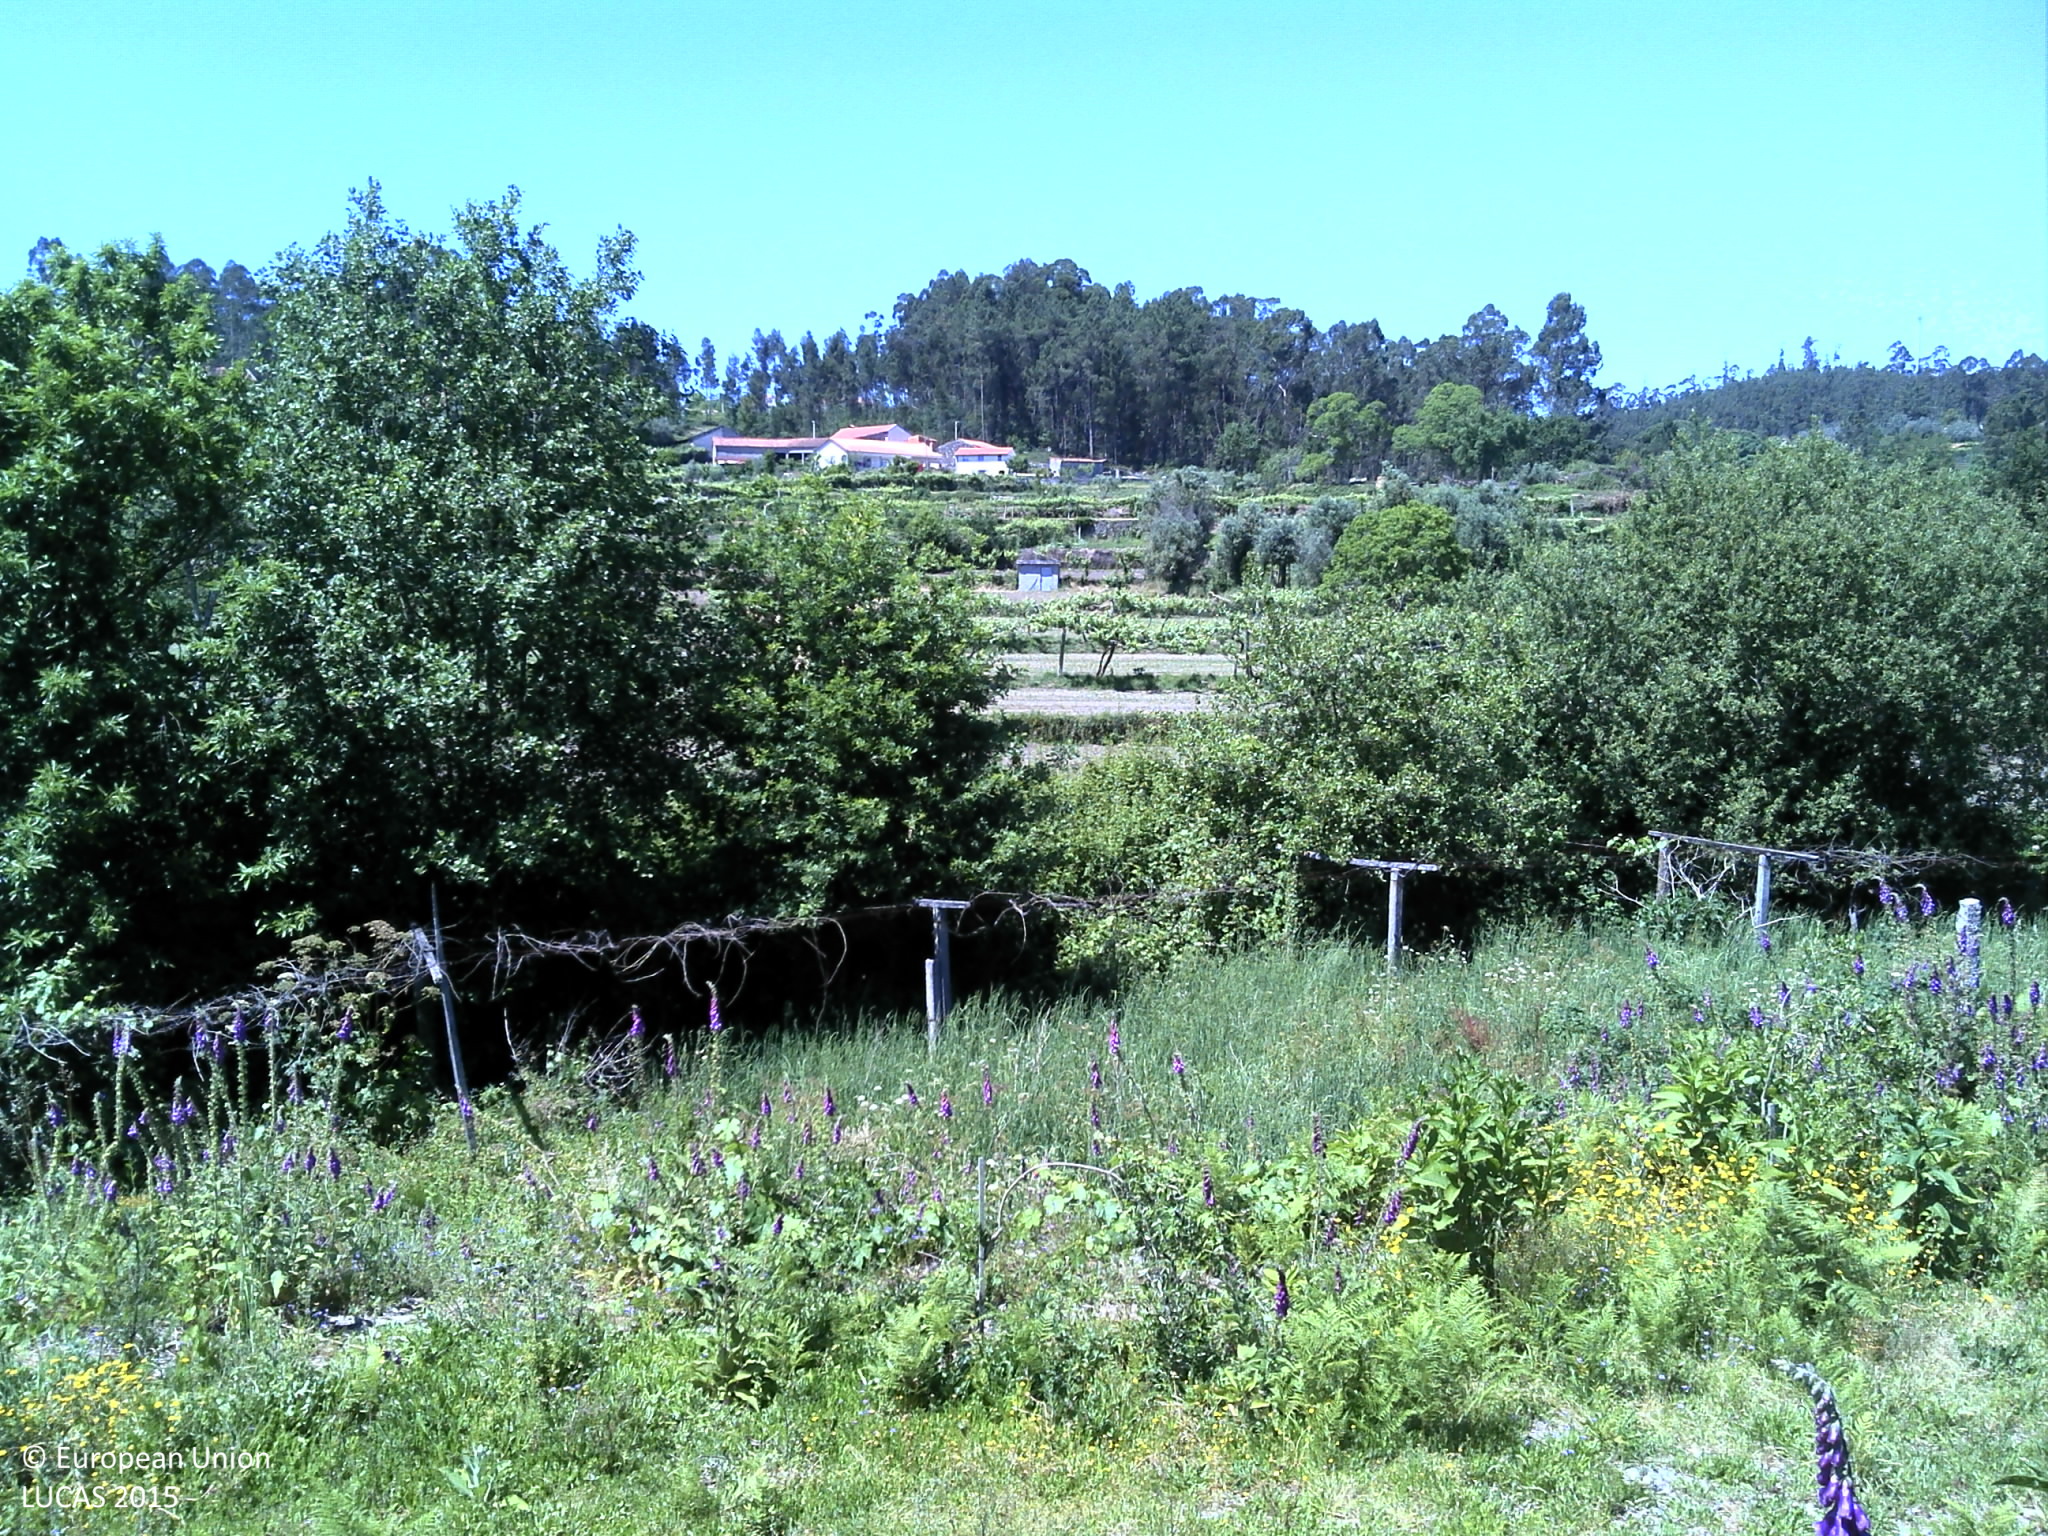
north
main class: Cropland
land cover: Olive groves
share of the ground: < 10 %
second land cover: Grassland without tree/shrub cover
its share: 50 - 75 %
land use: Agriculture (excluding fallow land and kitchen gardens)
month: May
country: PT
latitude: 41.6494
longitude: -8.6162
